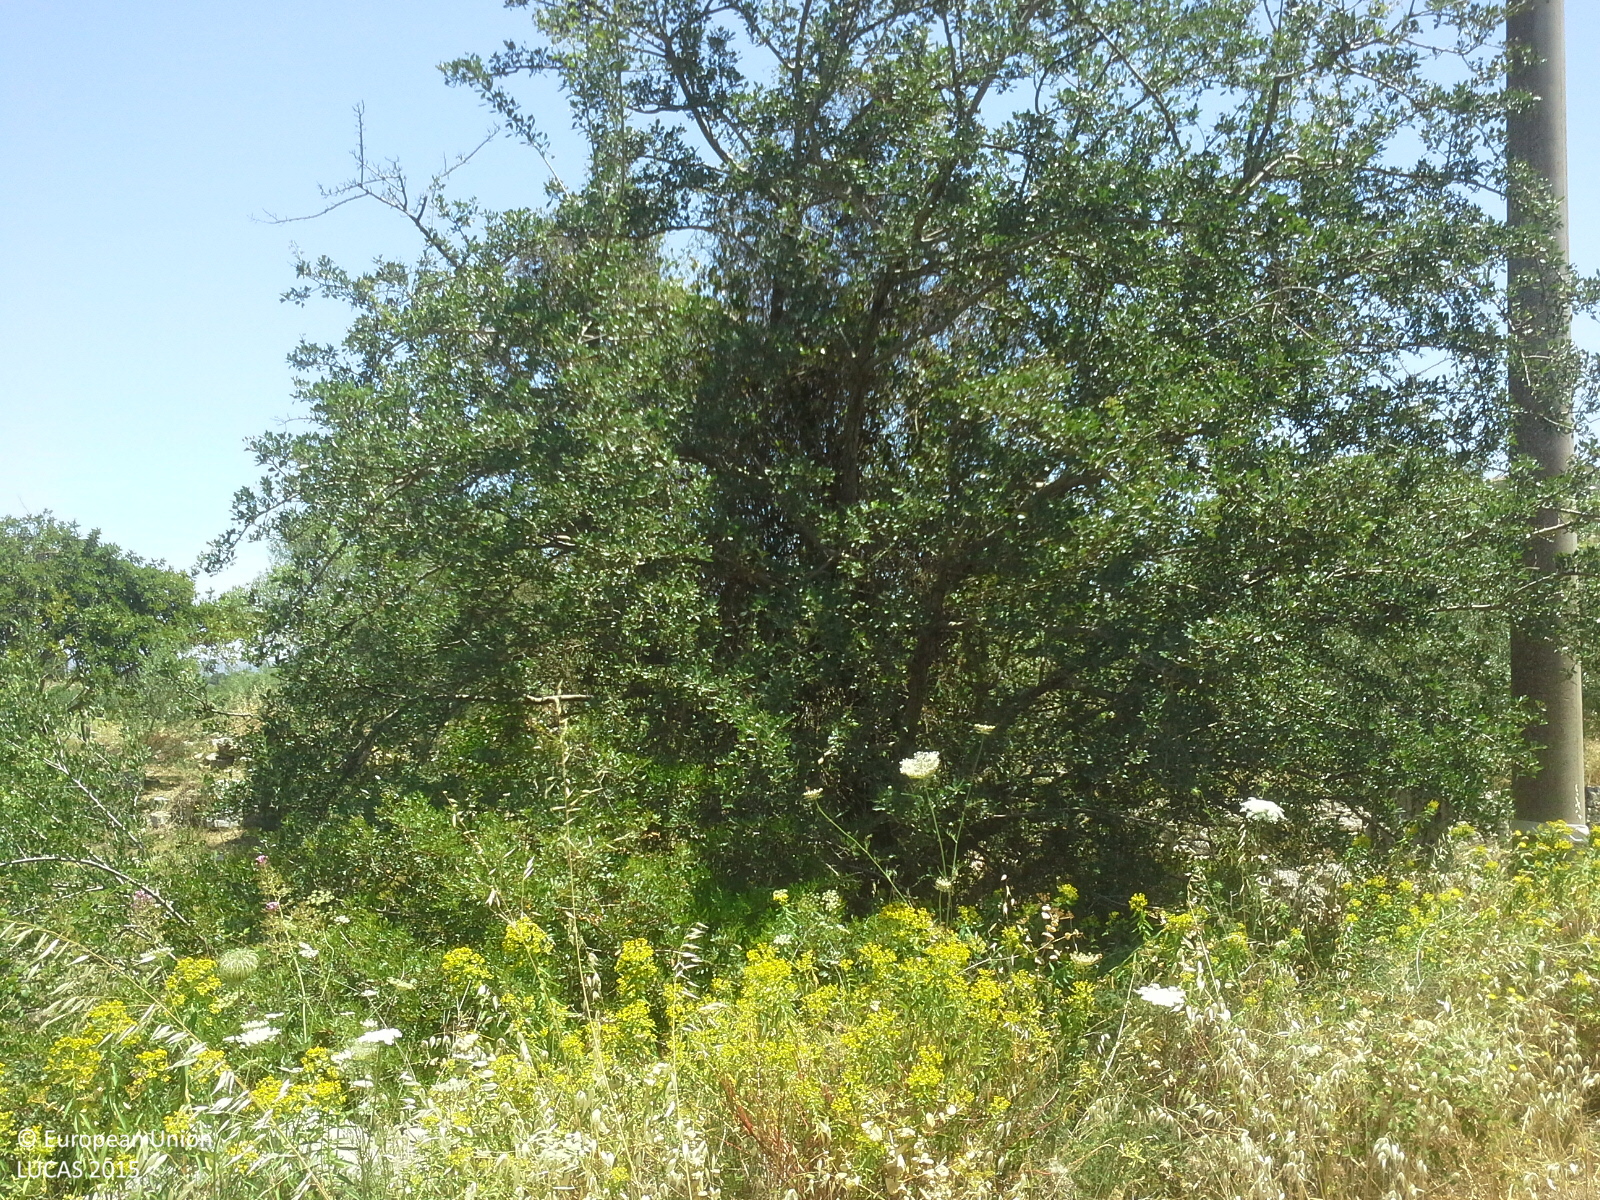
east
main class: Grassland
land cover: Grassland with sparse tree/shrub cover
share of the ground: > 75 %
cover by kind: herbaceous plants 95 %, coniferous forest trees 5 %
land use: Agriculture (excluding fallow land and kitchen gardens)
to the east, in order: Grassland with sparse tree/shrub cover; Electric lines; Dry stone walls; Grassland with sparse tree/shrub cover; Dry stone walls; Grassland with sparse tree/shrub cover; Shruby margins; Other cereals; Shruby margins; Grassland with sparse tree/shrub cover; Shruby margins; Other cereals; Dry stone walls; Grassland with sparse tree/shrub cover; Dry stone walls; Grassland with sparse tree/shrub cover; Olive groves; Grassland with sparse tree/shrub cover; Dry stone walls
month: June
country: IT
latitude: 36.9147
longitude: 14.8443
